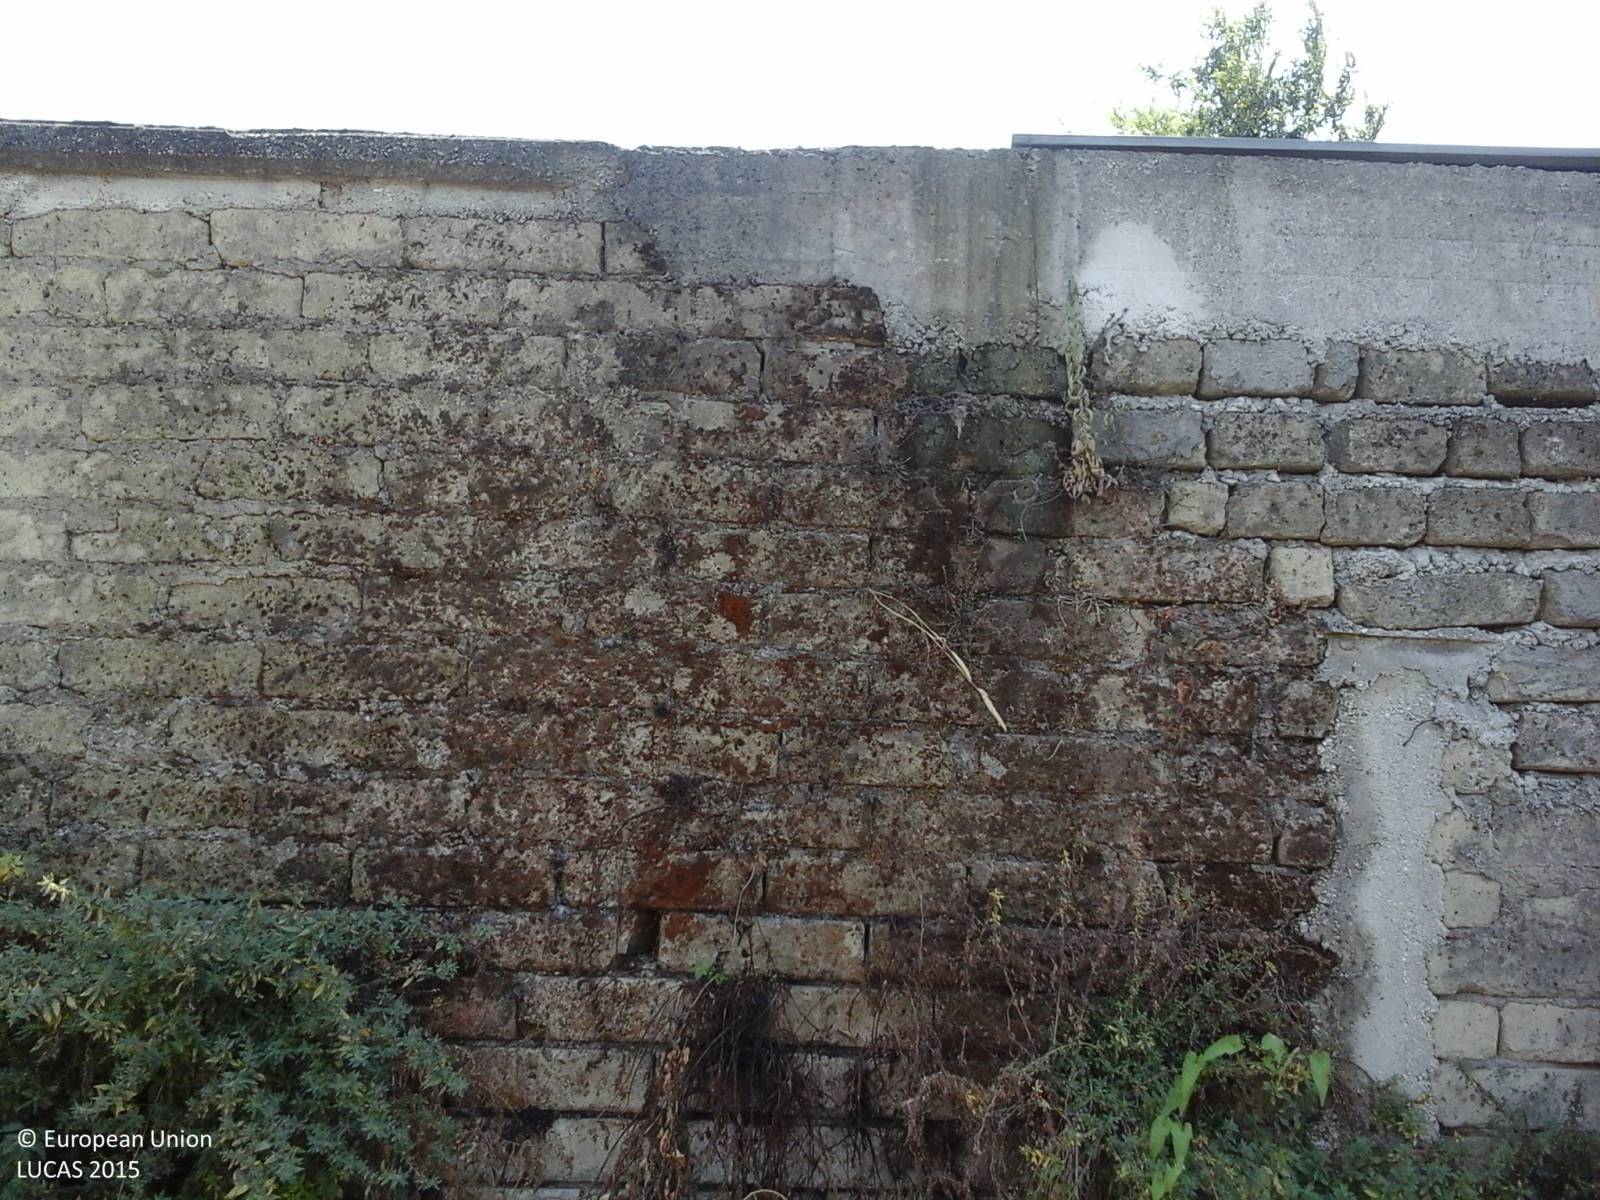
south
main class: Grassland
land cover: Spontaneously vegetated surfaces
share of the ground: > 75 %
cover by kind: herbaceous plants 100 %
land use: Agriculture (excluding fallow land and kitchen gardens)
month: July
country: IT
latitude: 40.9764
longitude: 14.1543
